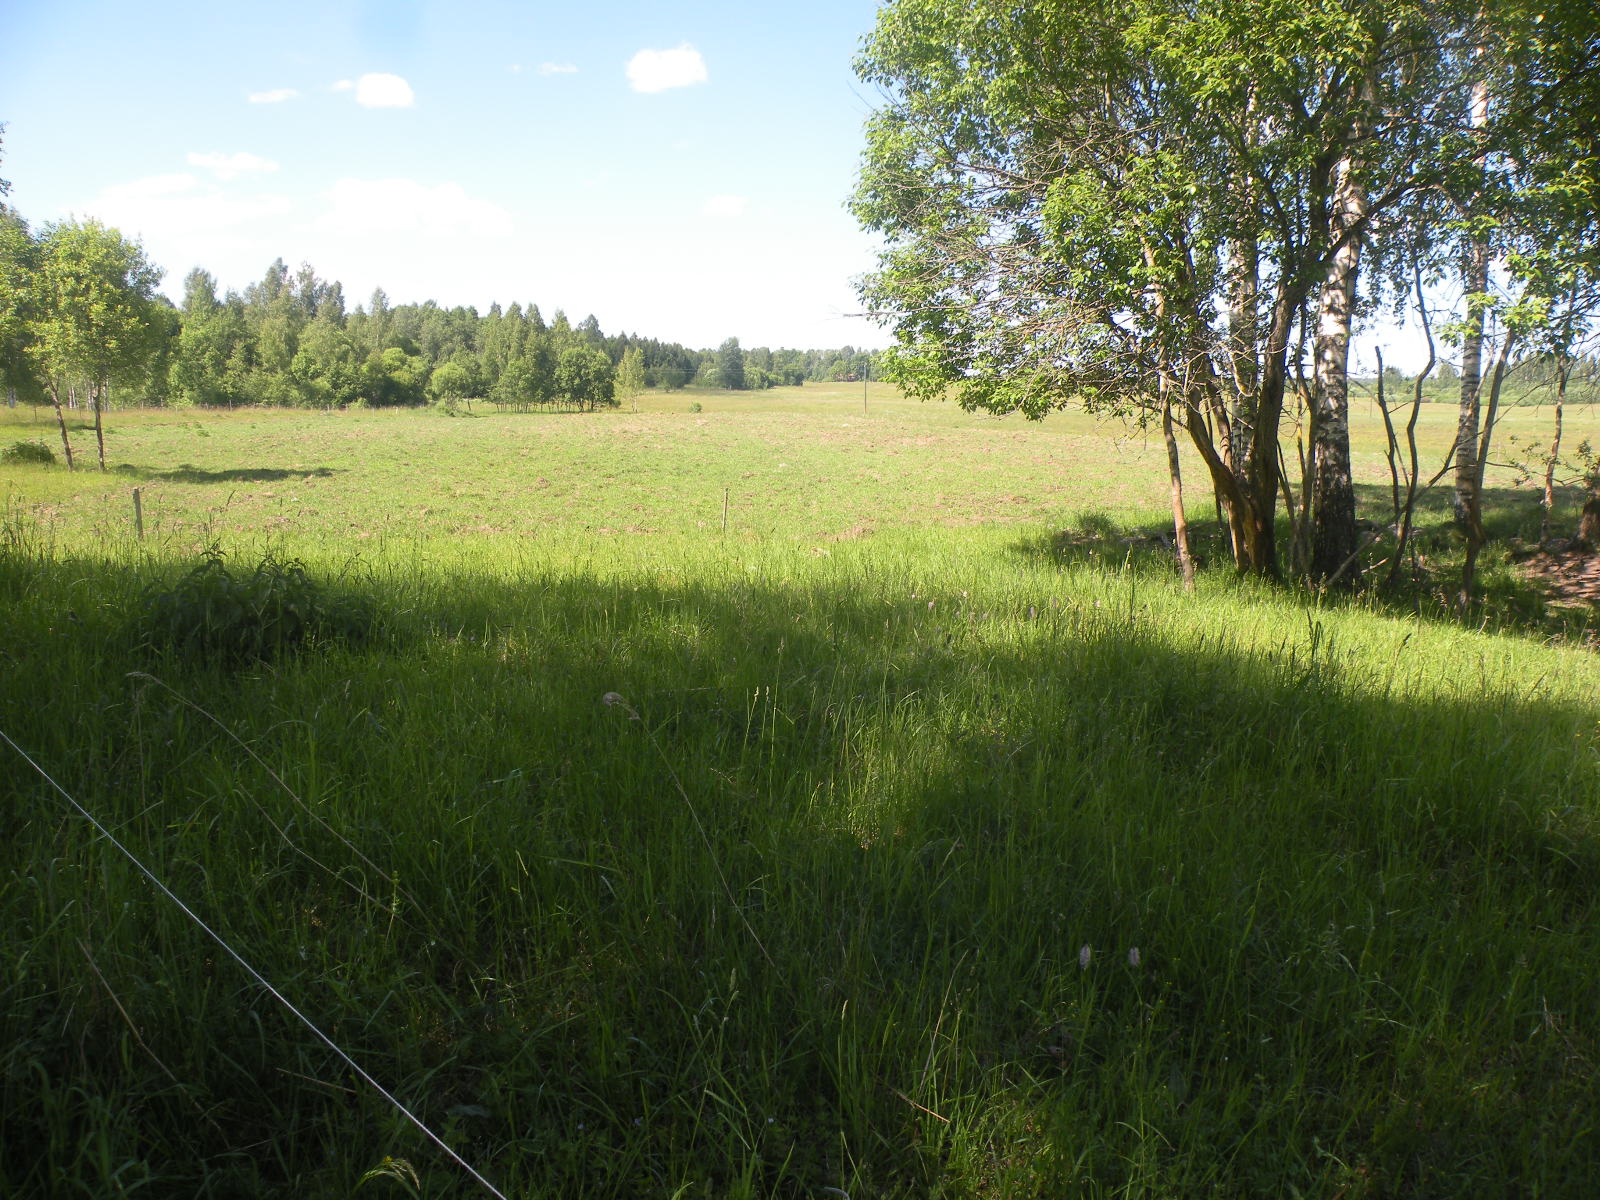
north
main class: Grassland
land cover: Grassland without tree/shrub cover
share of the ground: > 75 %
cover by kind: herbaceous plants 100 %
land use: Agriculture (excluding fallow land and kitchen gardens)
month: June
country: LV
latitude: 55.9311
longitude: 26.9548
